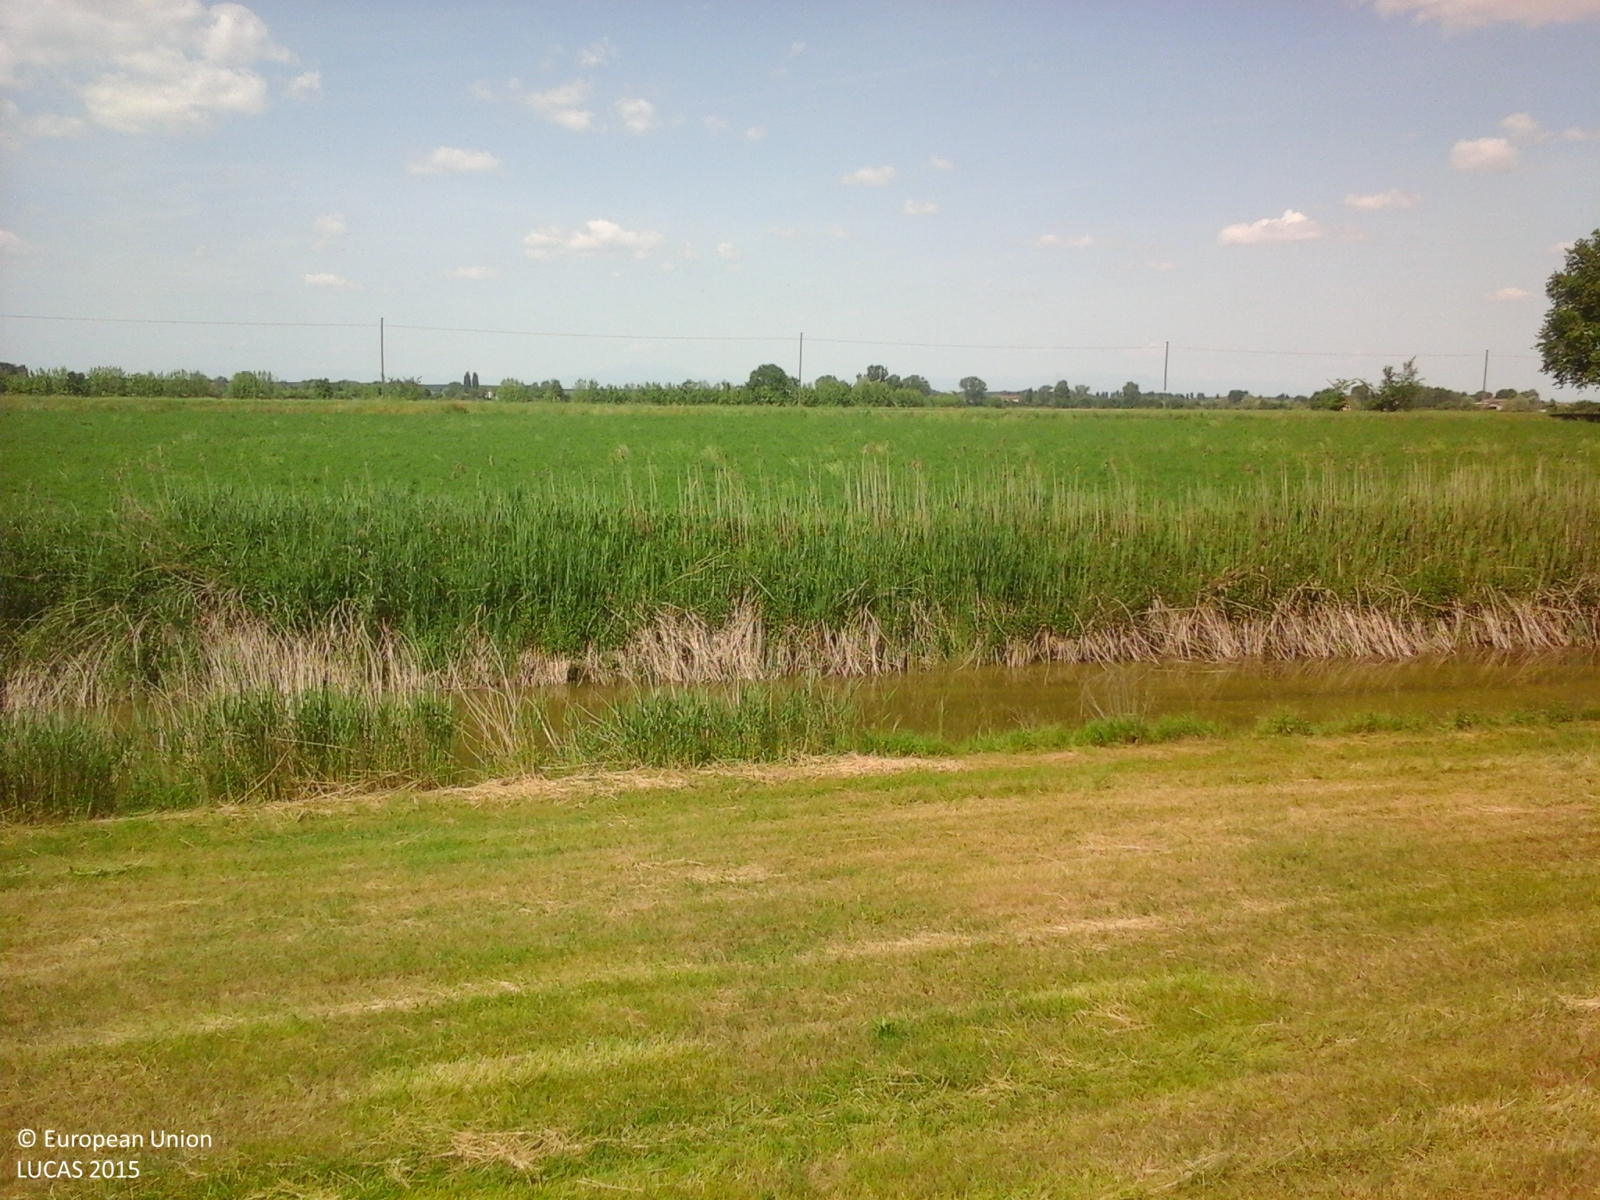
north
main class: Grassland
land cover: Grassland without tree/shrub cover
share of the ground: > 75 %
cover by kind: herbaceous plants 100 %
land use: Agriculture (excluding fallow land and kitchen gardens)
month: May
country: IT
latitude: 45.0145
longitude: 10.8232
